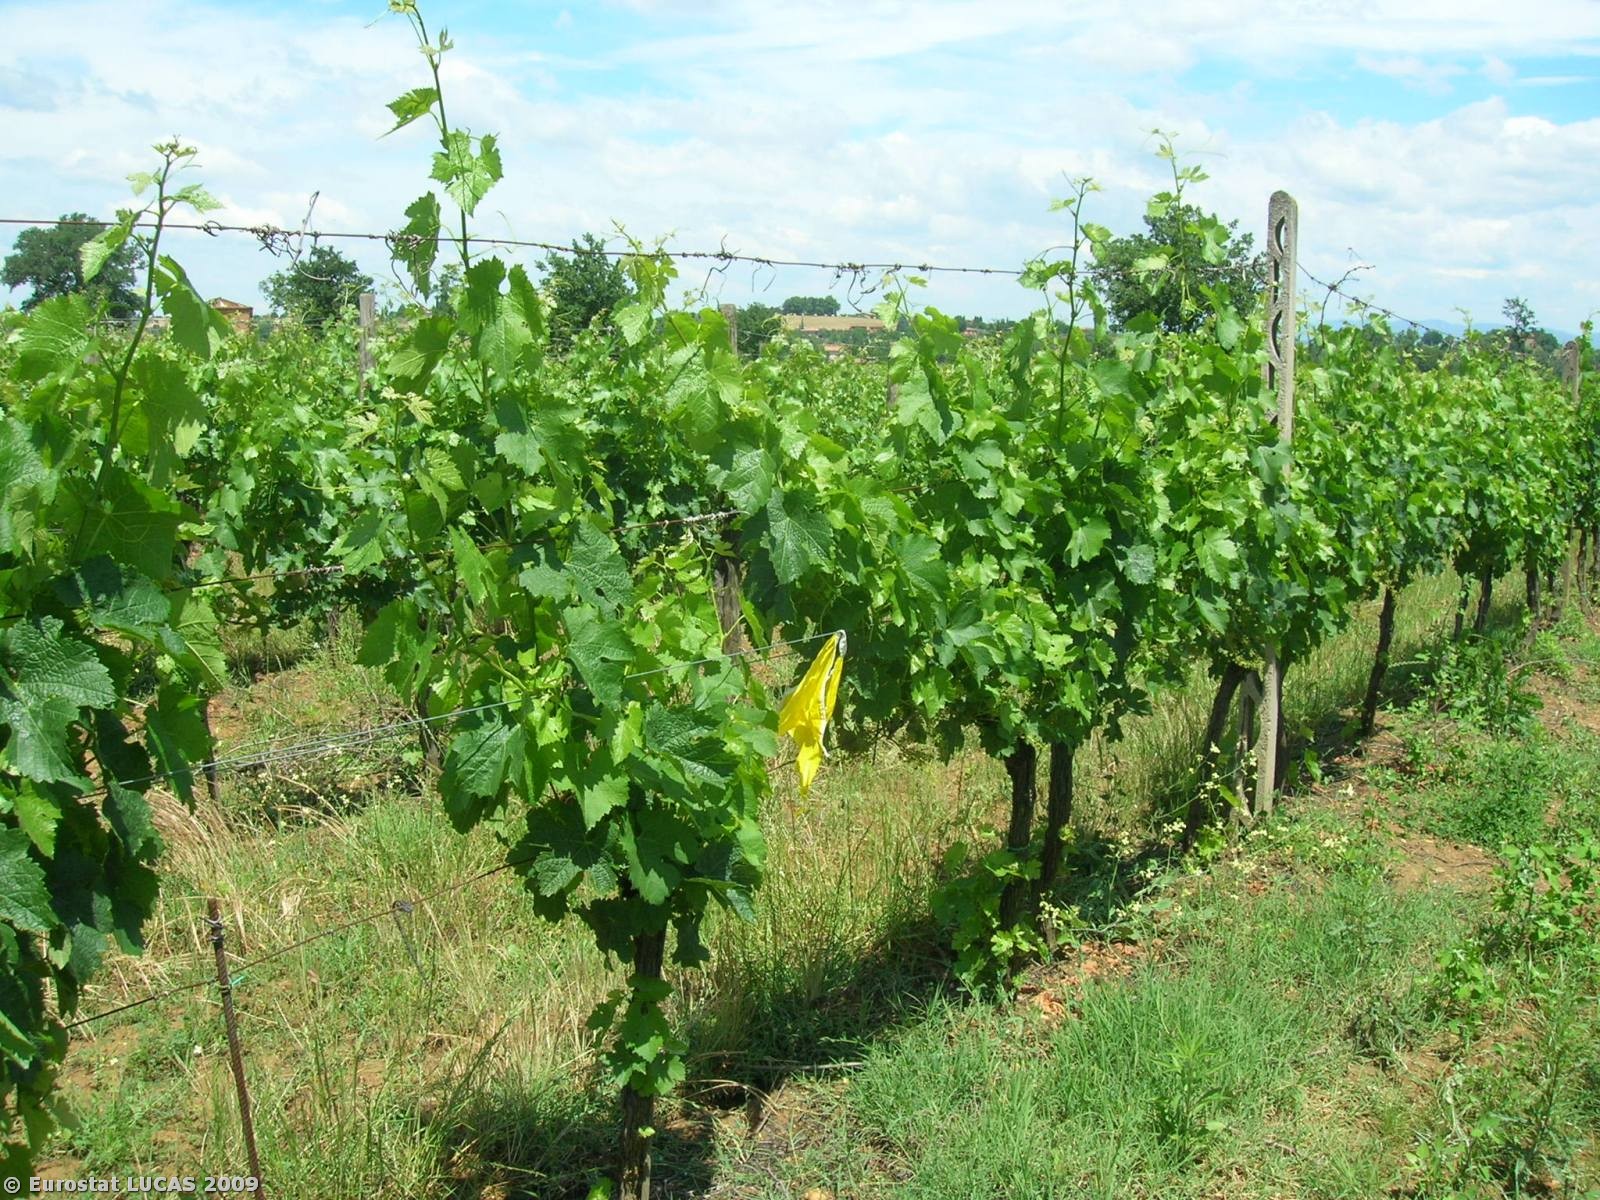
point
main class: Cropland
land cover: Vineyards
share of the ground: 25 - 50 %
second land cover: Spontaneously vegetated surfaces
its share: > 75 %
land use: Agriculture (excluding fallow land and kitchen gardens)
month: June
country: IT
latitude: 43.1067
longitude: 11.8500
